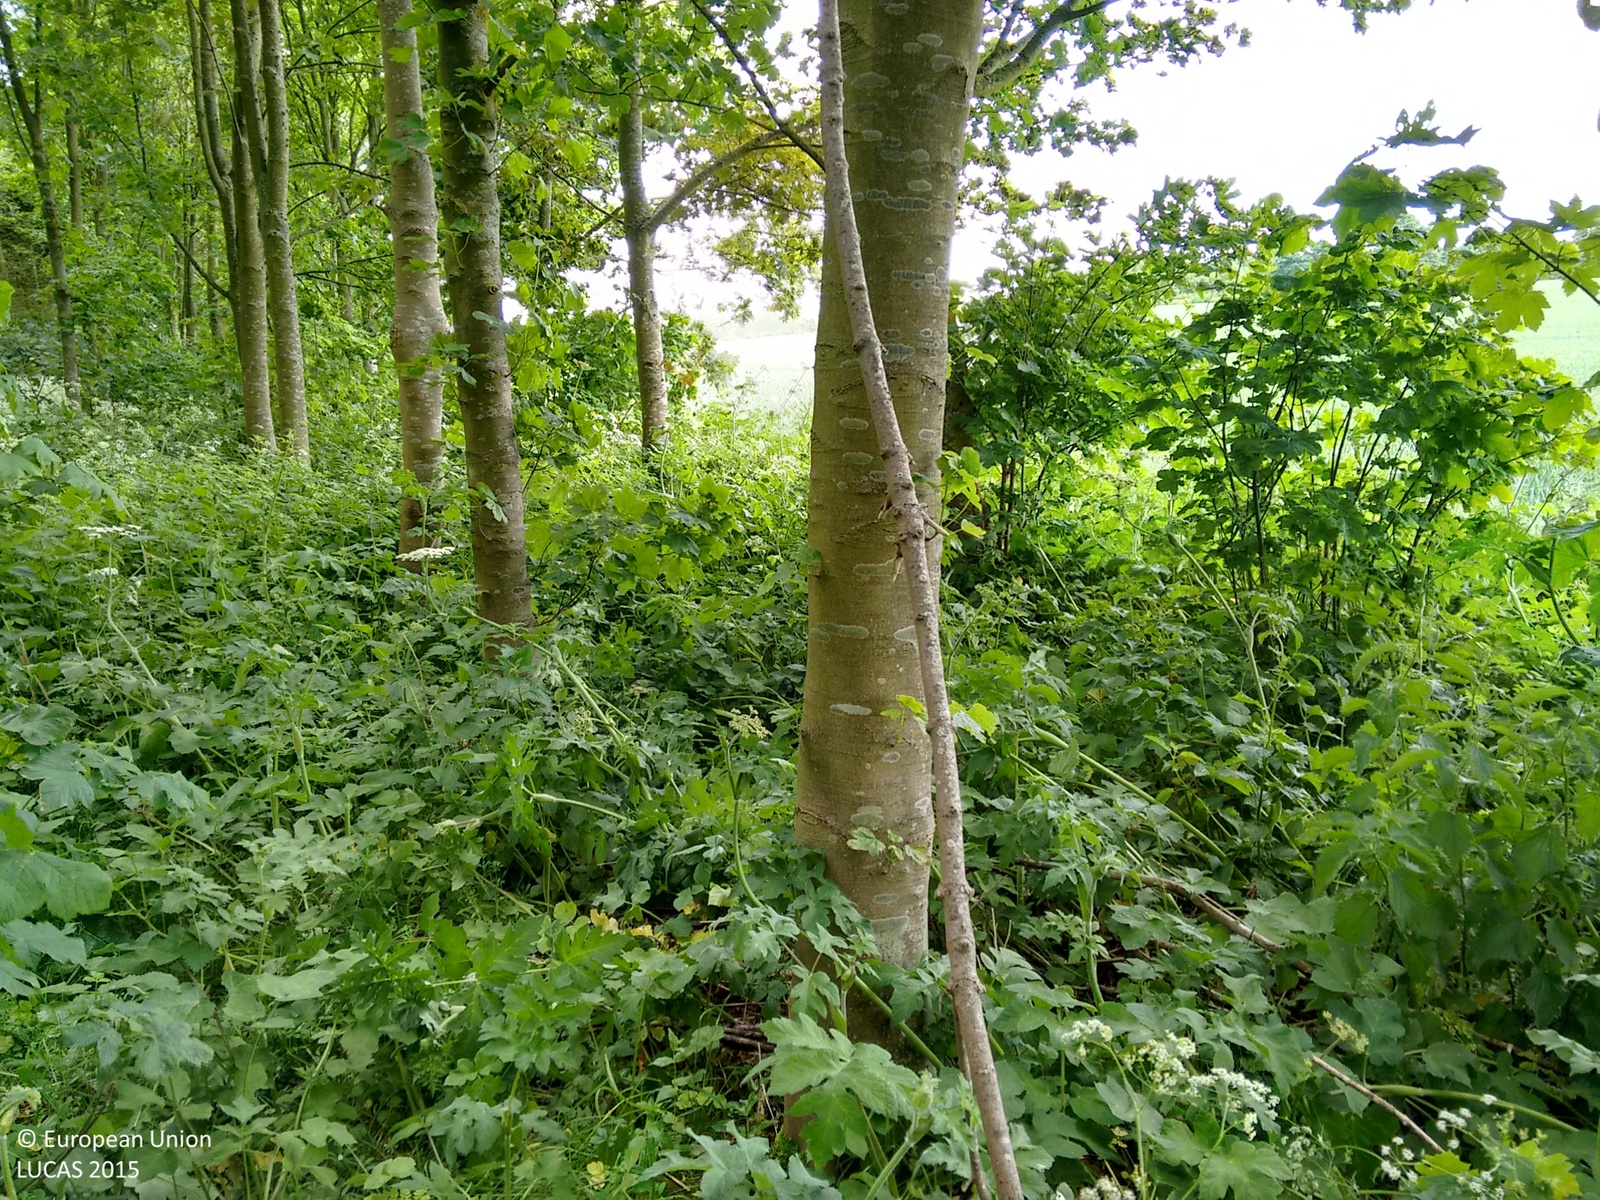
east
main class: Woodland
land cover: Broadleaved woodland
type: mesophytic deciduous forest
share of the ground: > 75 %
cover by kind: broadleaved forest trees 100 %
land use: Agriculture (excluding fallow land and kitchen gardens)
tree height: > 5 m
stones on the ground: < 10 %
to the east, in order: Broadleaved woodland; Grass margins; Common wheat
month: June
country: GB
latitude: 52.8017
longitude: -0.6750
